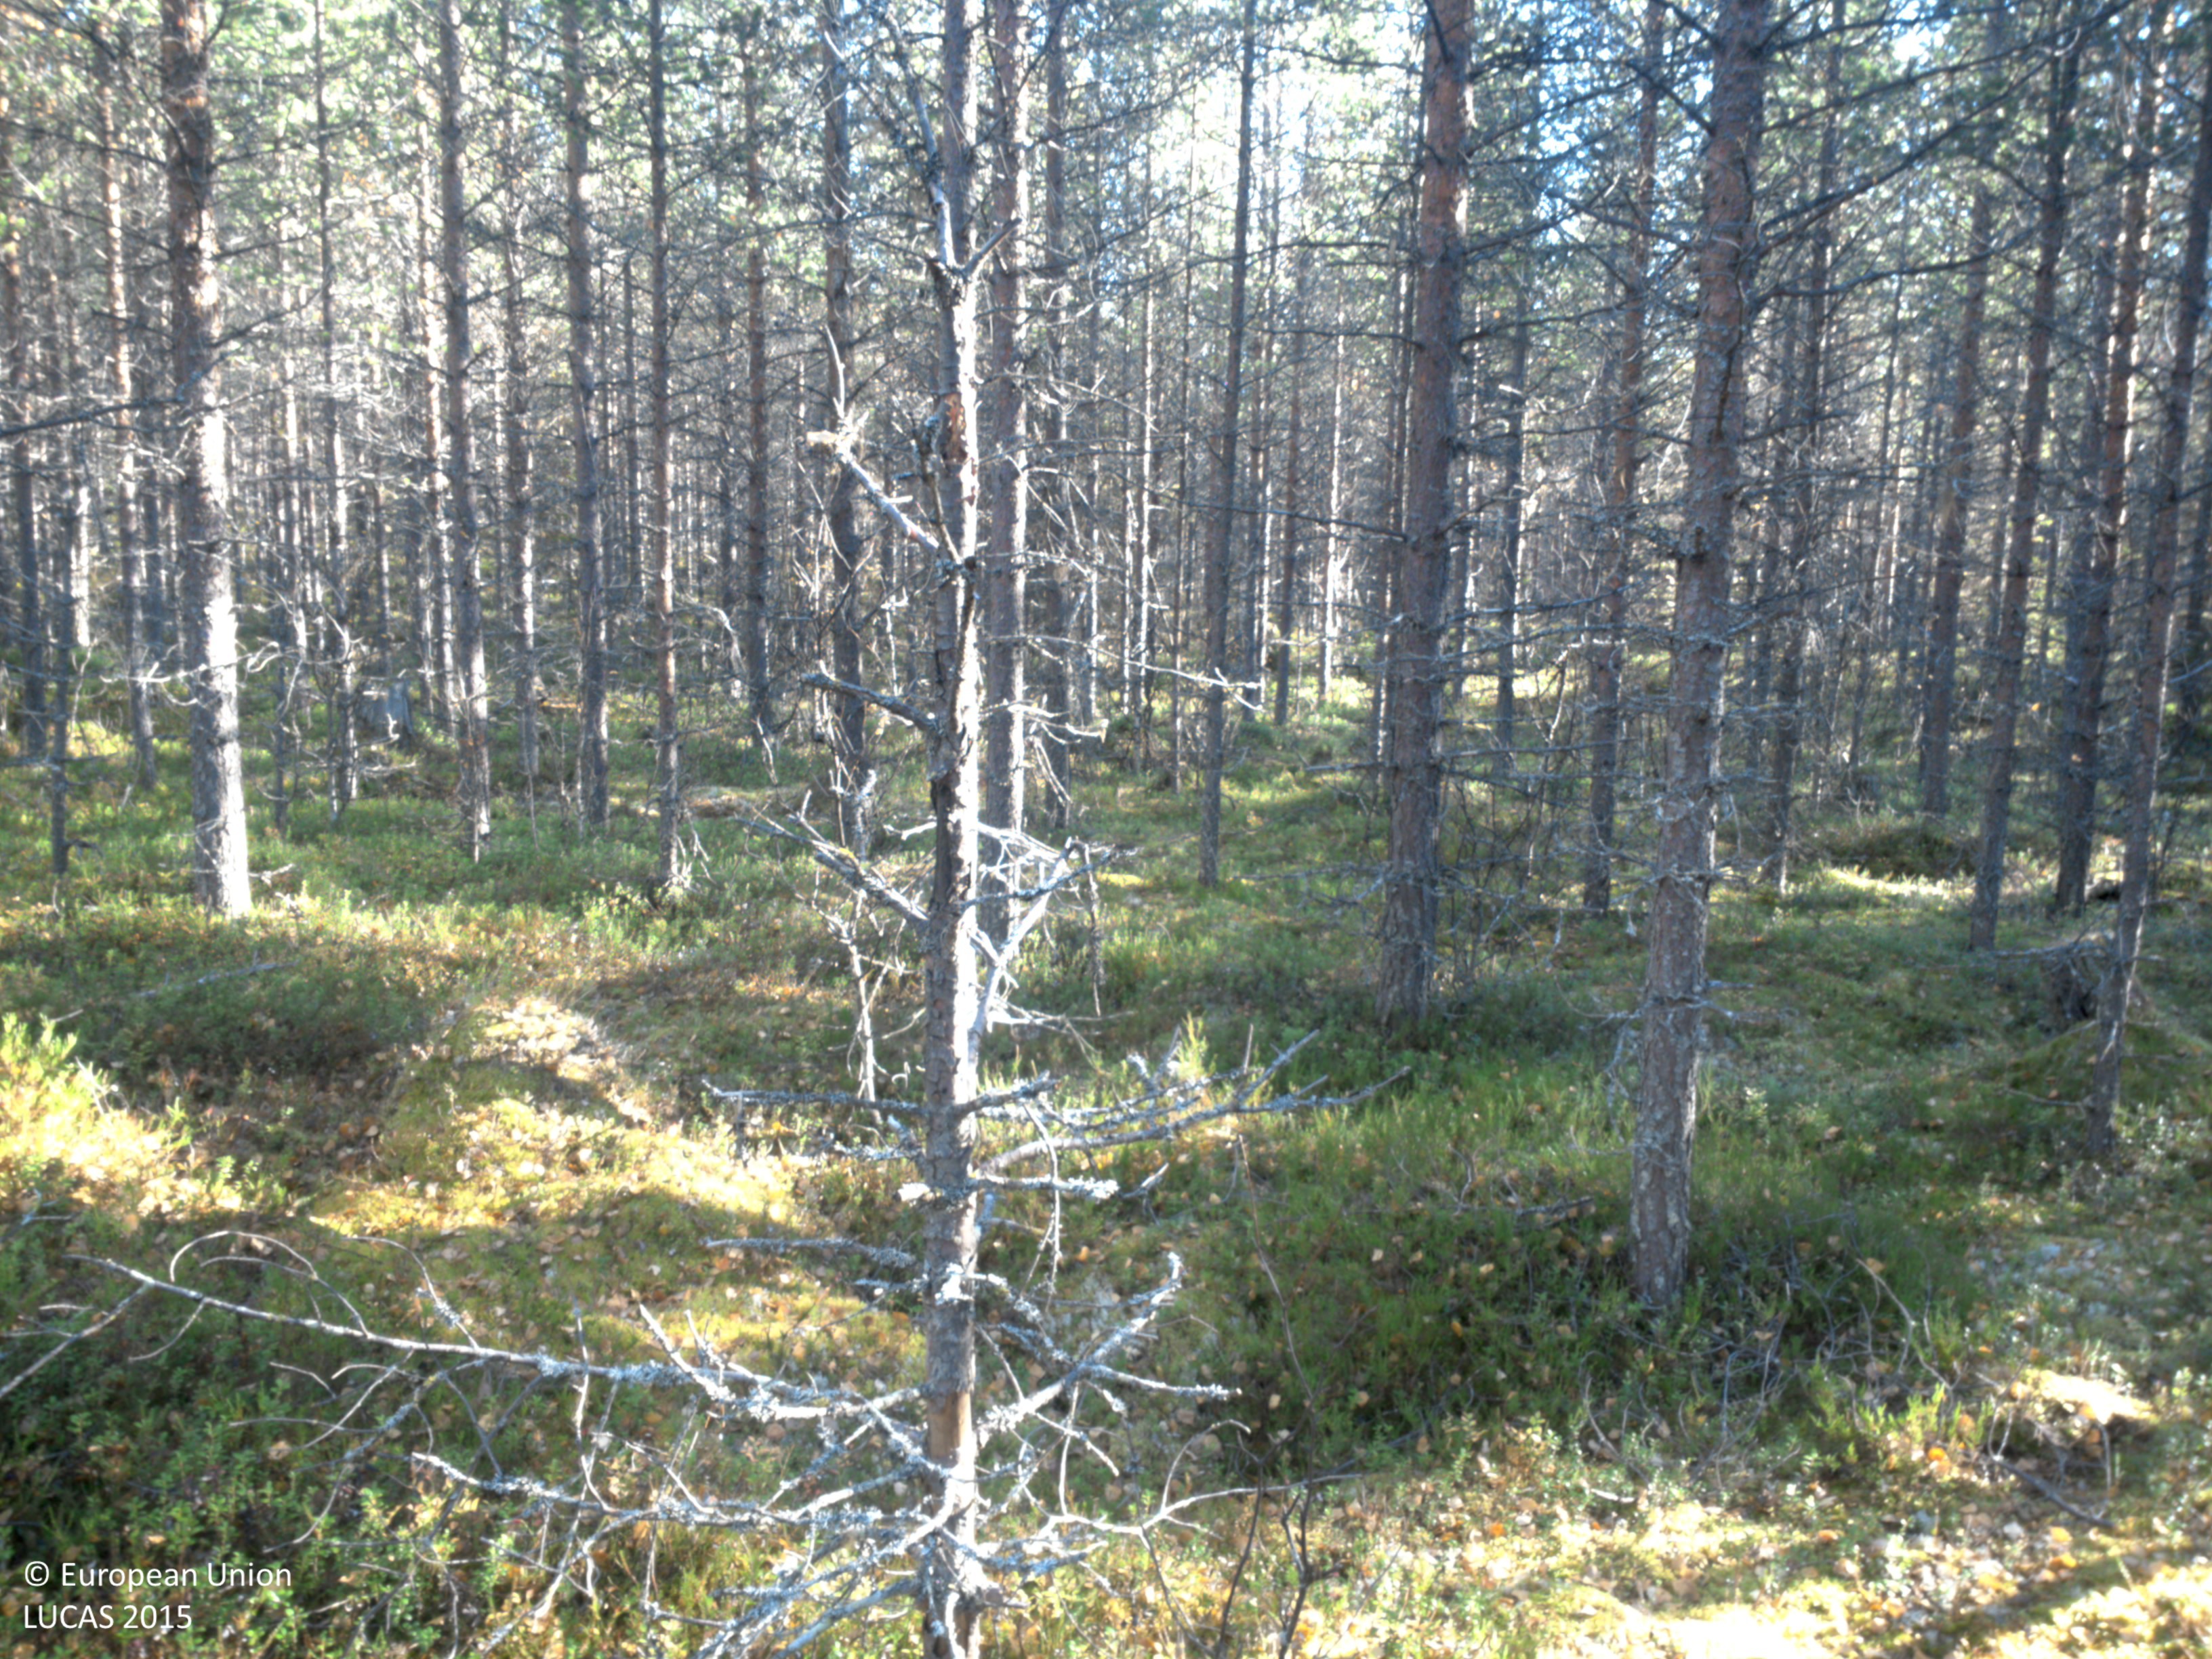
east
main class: Woodland
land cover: Pine dominated coniferous woodland
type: boreal forest
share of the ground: > 75 %
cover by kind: coniferous forest trees 80 %, shrubs 15 %, lichens and mosses 5 %
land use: Forestry
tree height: > 5 m
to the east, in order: Pine dominated coniferous woodland
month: October
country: SE
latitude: 64.8134
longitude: 18.3685
